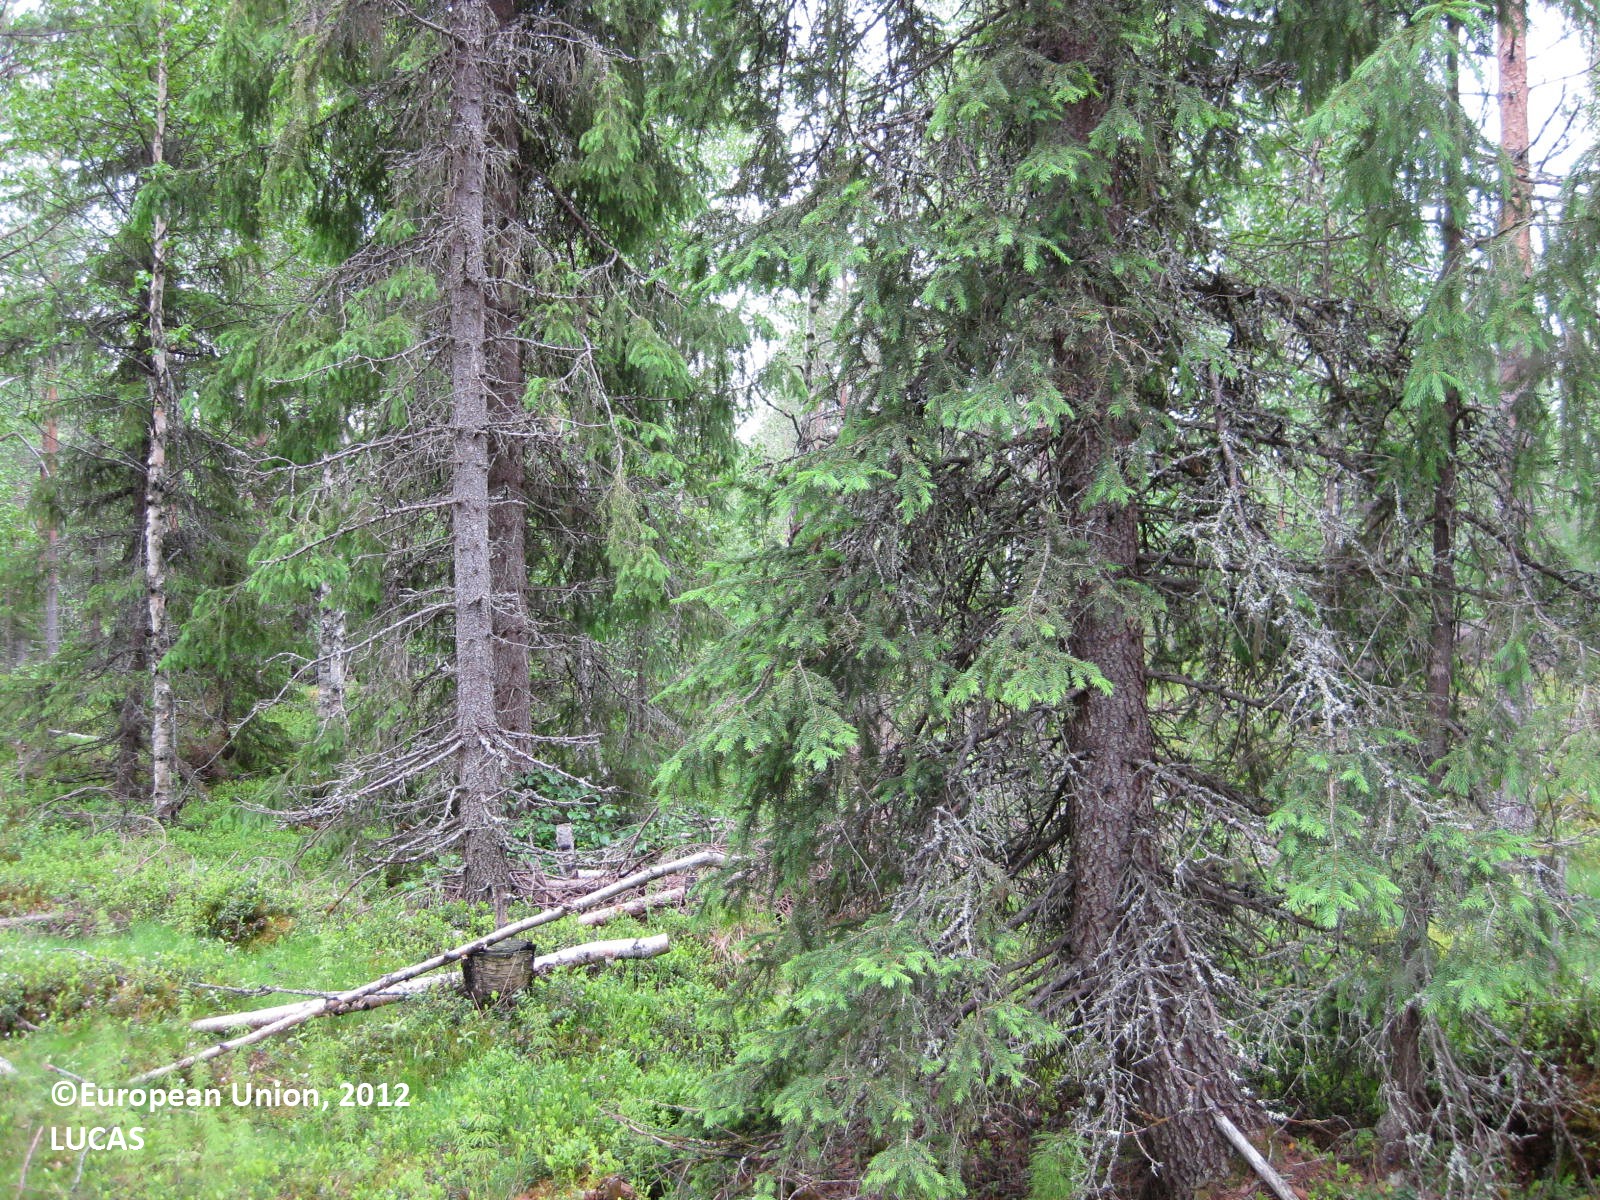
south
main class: Woodland
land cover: Other mixed woodland
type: boreal forest
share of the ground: > 75 %
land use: Forestry
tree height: > 5 m
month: June
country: FI
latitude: 65.1964
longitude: 28.2083
